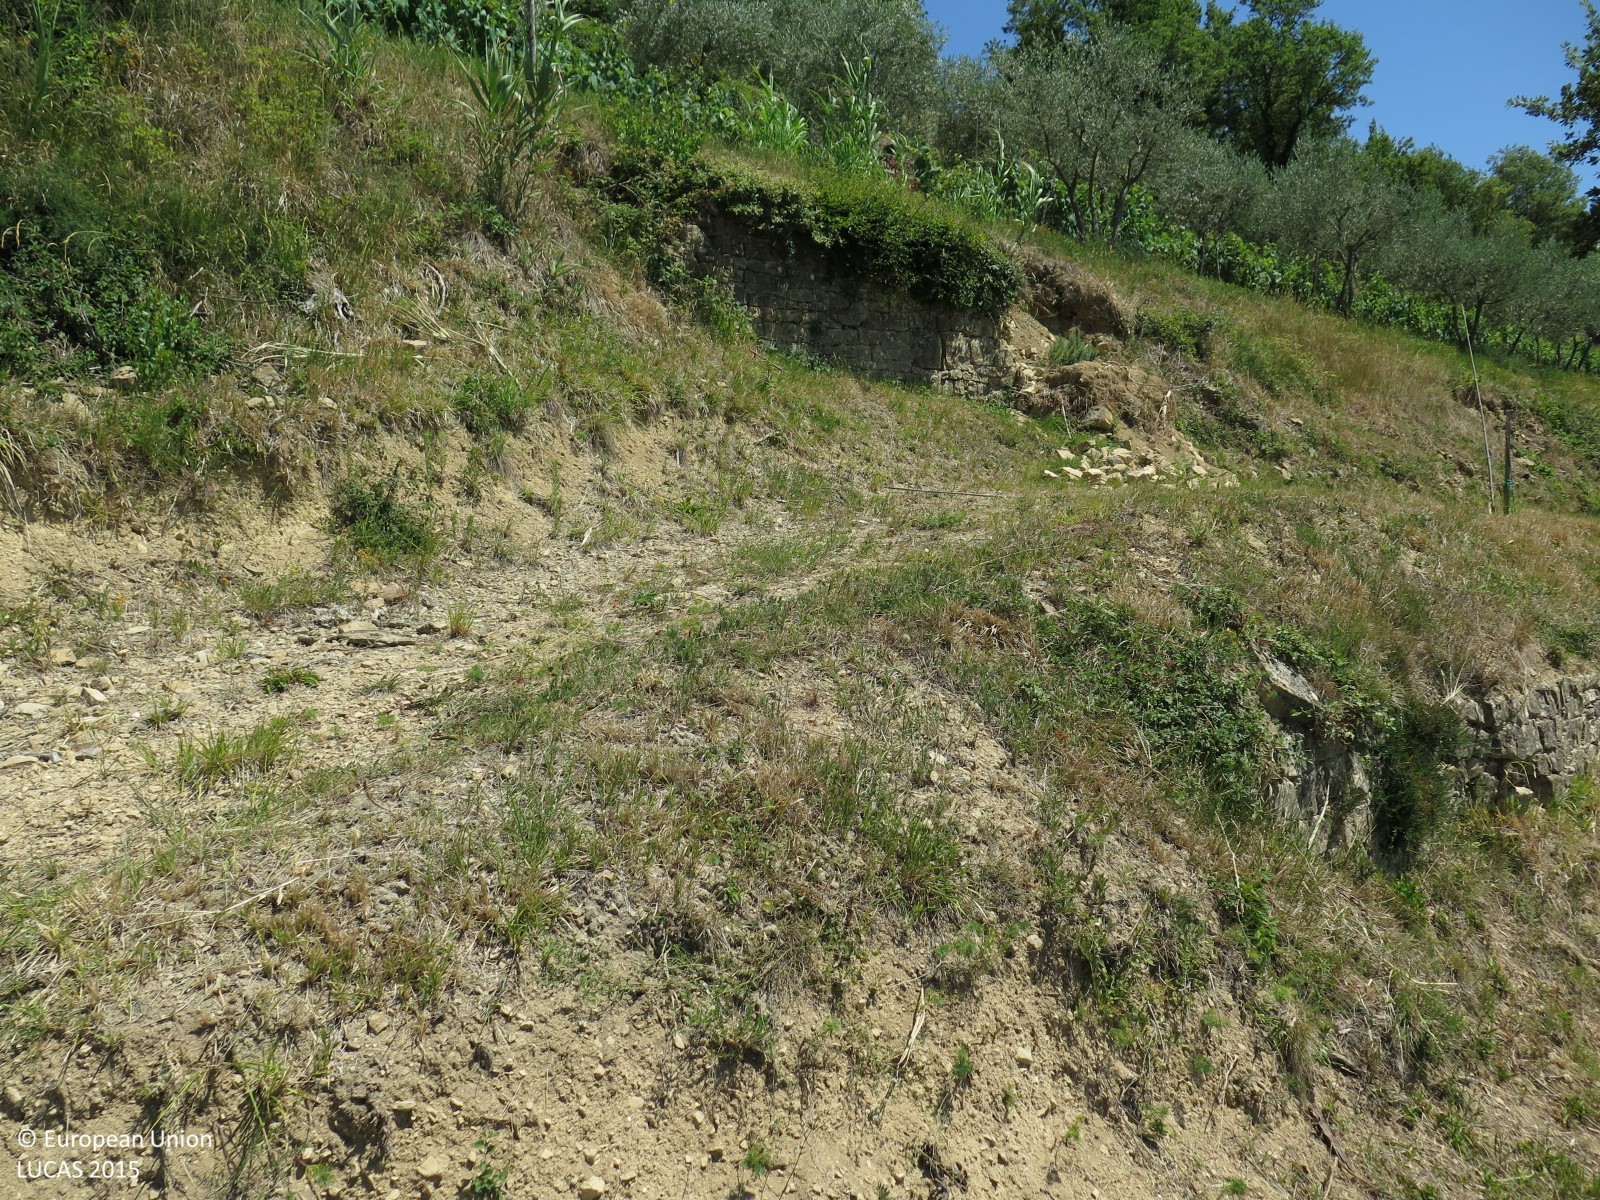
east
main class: Woodland
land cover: Pine dominated mixed woodland
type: coniferous forest of the mediterranean region
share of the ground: > 75 %
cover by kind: coniferous forest trees 75 %, broadleaved forest trees 25 %
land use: Semi-natural and natural areas not in use
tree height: > 5 m
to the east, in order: Pine dominated mixed woodland; Broadleaved woodland; Olive groves; Dry stone walls; Olive groves; Dry stone walls; Vineyards; Dry stone walls; Olive groves; Dry stone walls; Olive groves; Tracks; Dry stone walls; Artificial constructions in urban areas
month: July
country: HR
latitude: 45.3625
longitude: 13.8378
